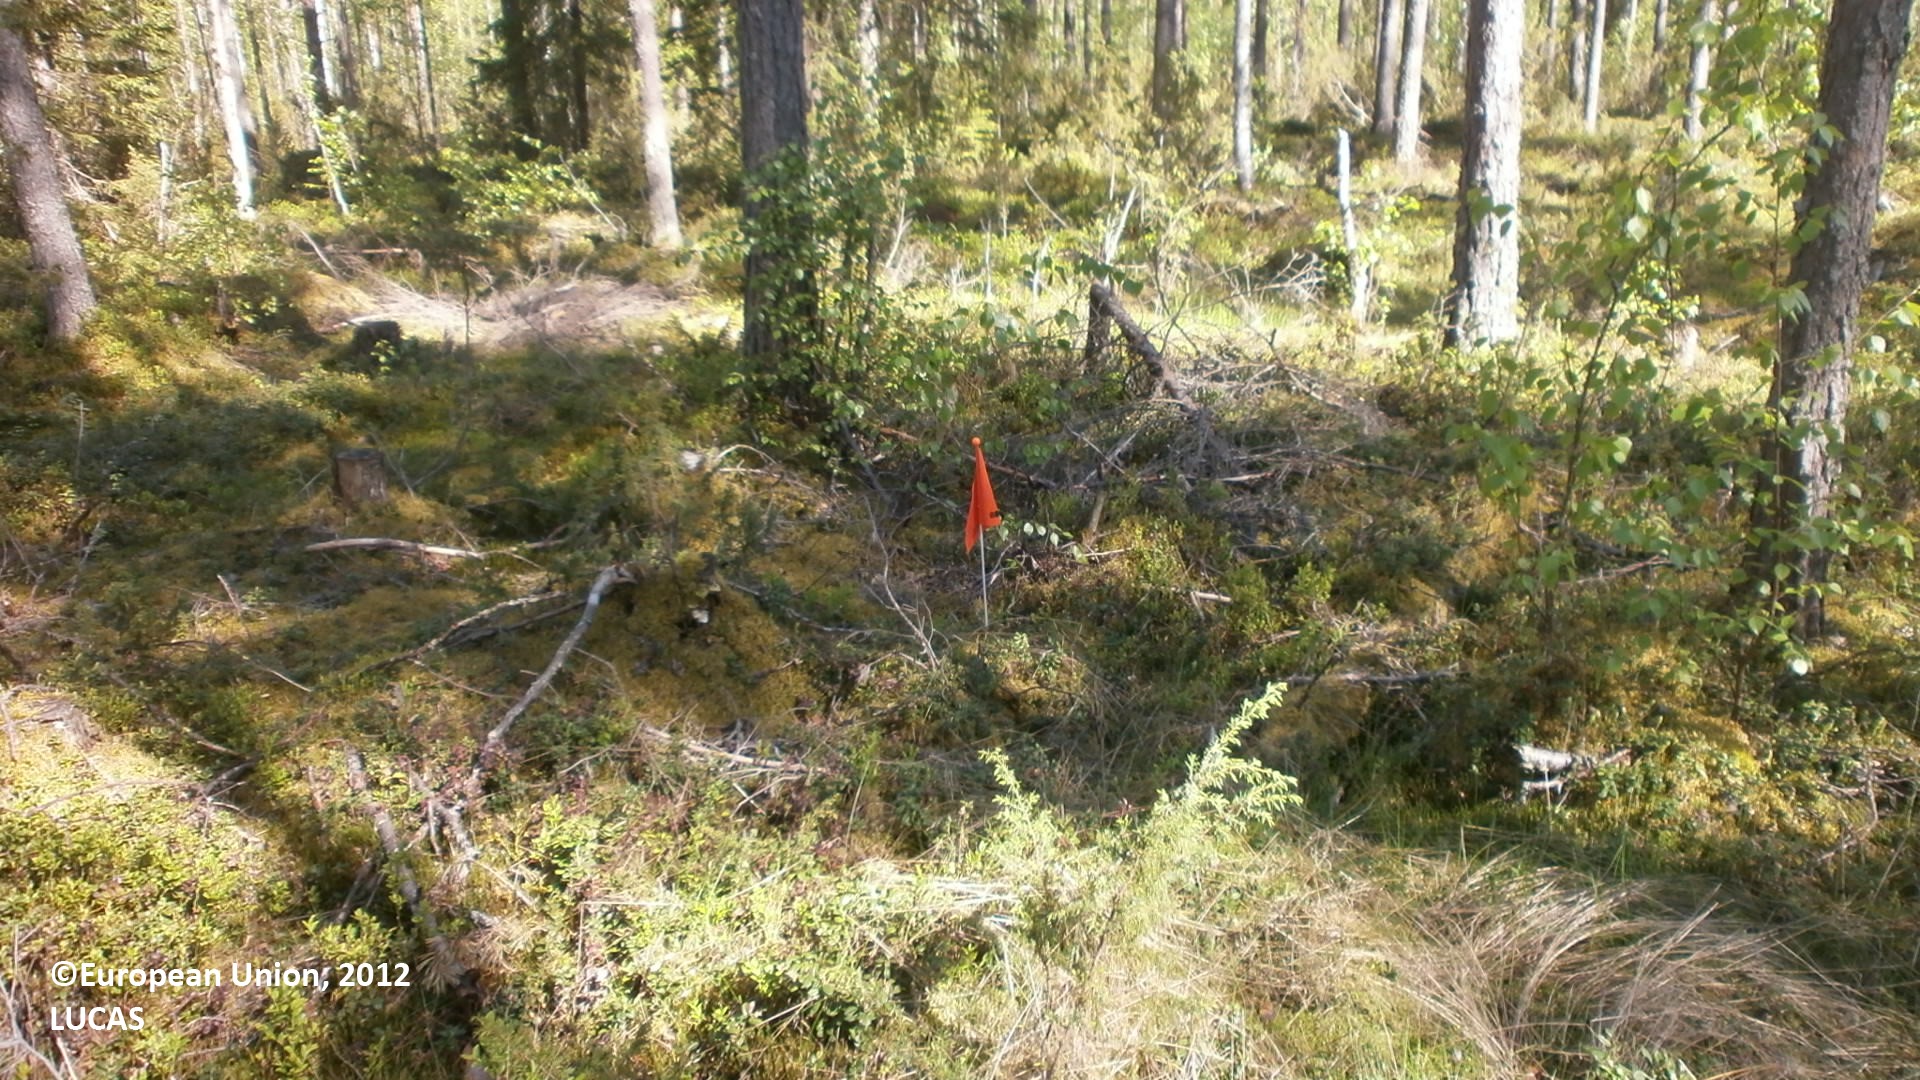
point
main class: Woodland
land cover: Pine dominated coniferous woodland
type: hemiboreal forest and nemoral coniferous forest and mixed broadleaved-coniferous forest
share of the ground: 25 - 50 %
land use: Forestry
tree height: > 5 m
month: June
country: FI
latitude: 64.1728
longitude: 25.7980
